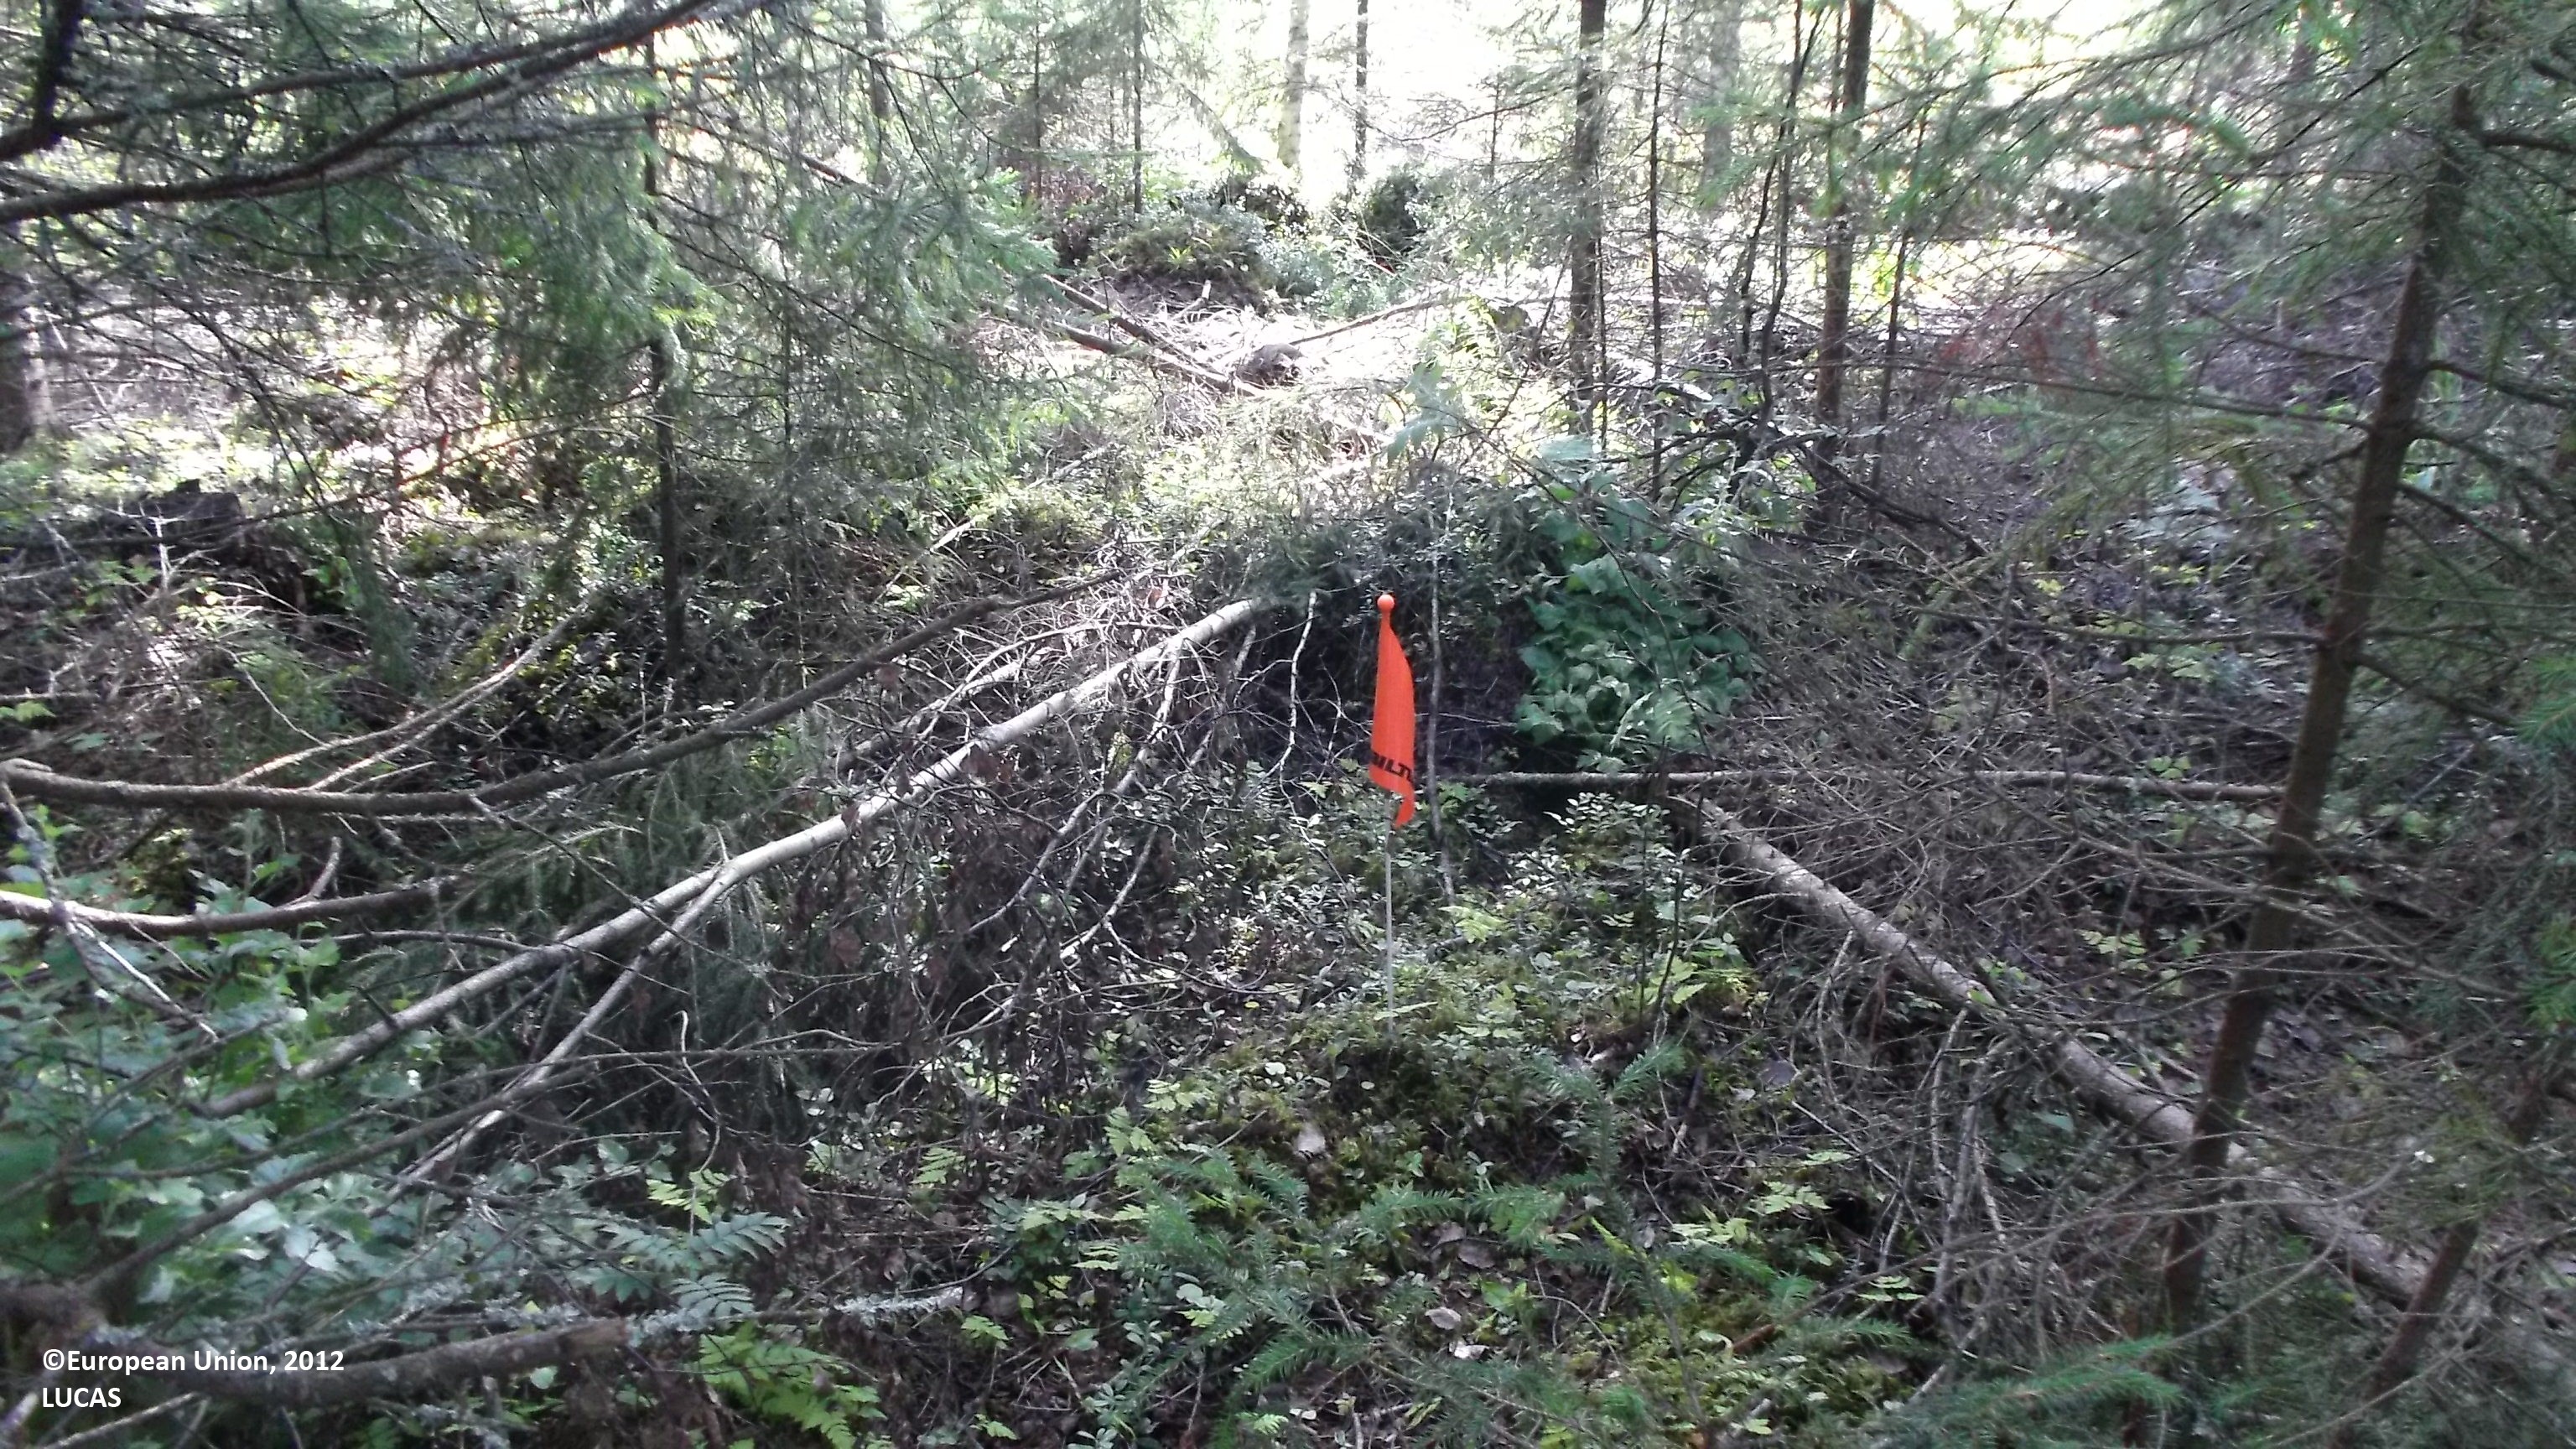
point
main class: Woodland
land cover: Spruce dominated coniferous woodland
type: boreal forest
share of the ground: 50 - 75 %
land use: Forestry
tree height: > 5 m
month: August
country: FI
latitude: 63.9001
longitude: 23.4009
